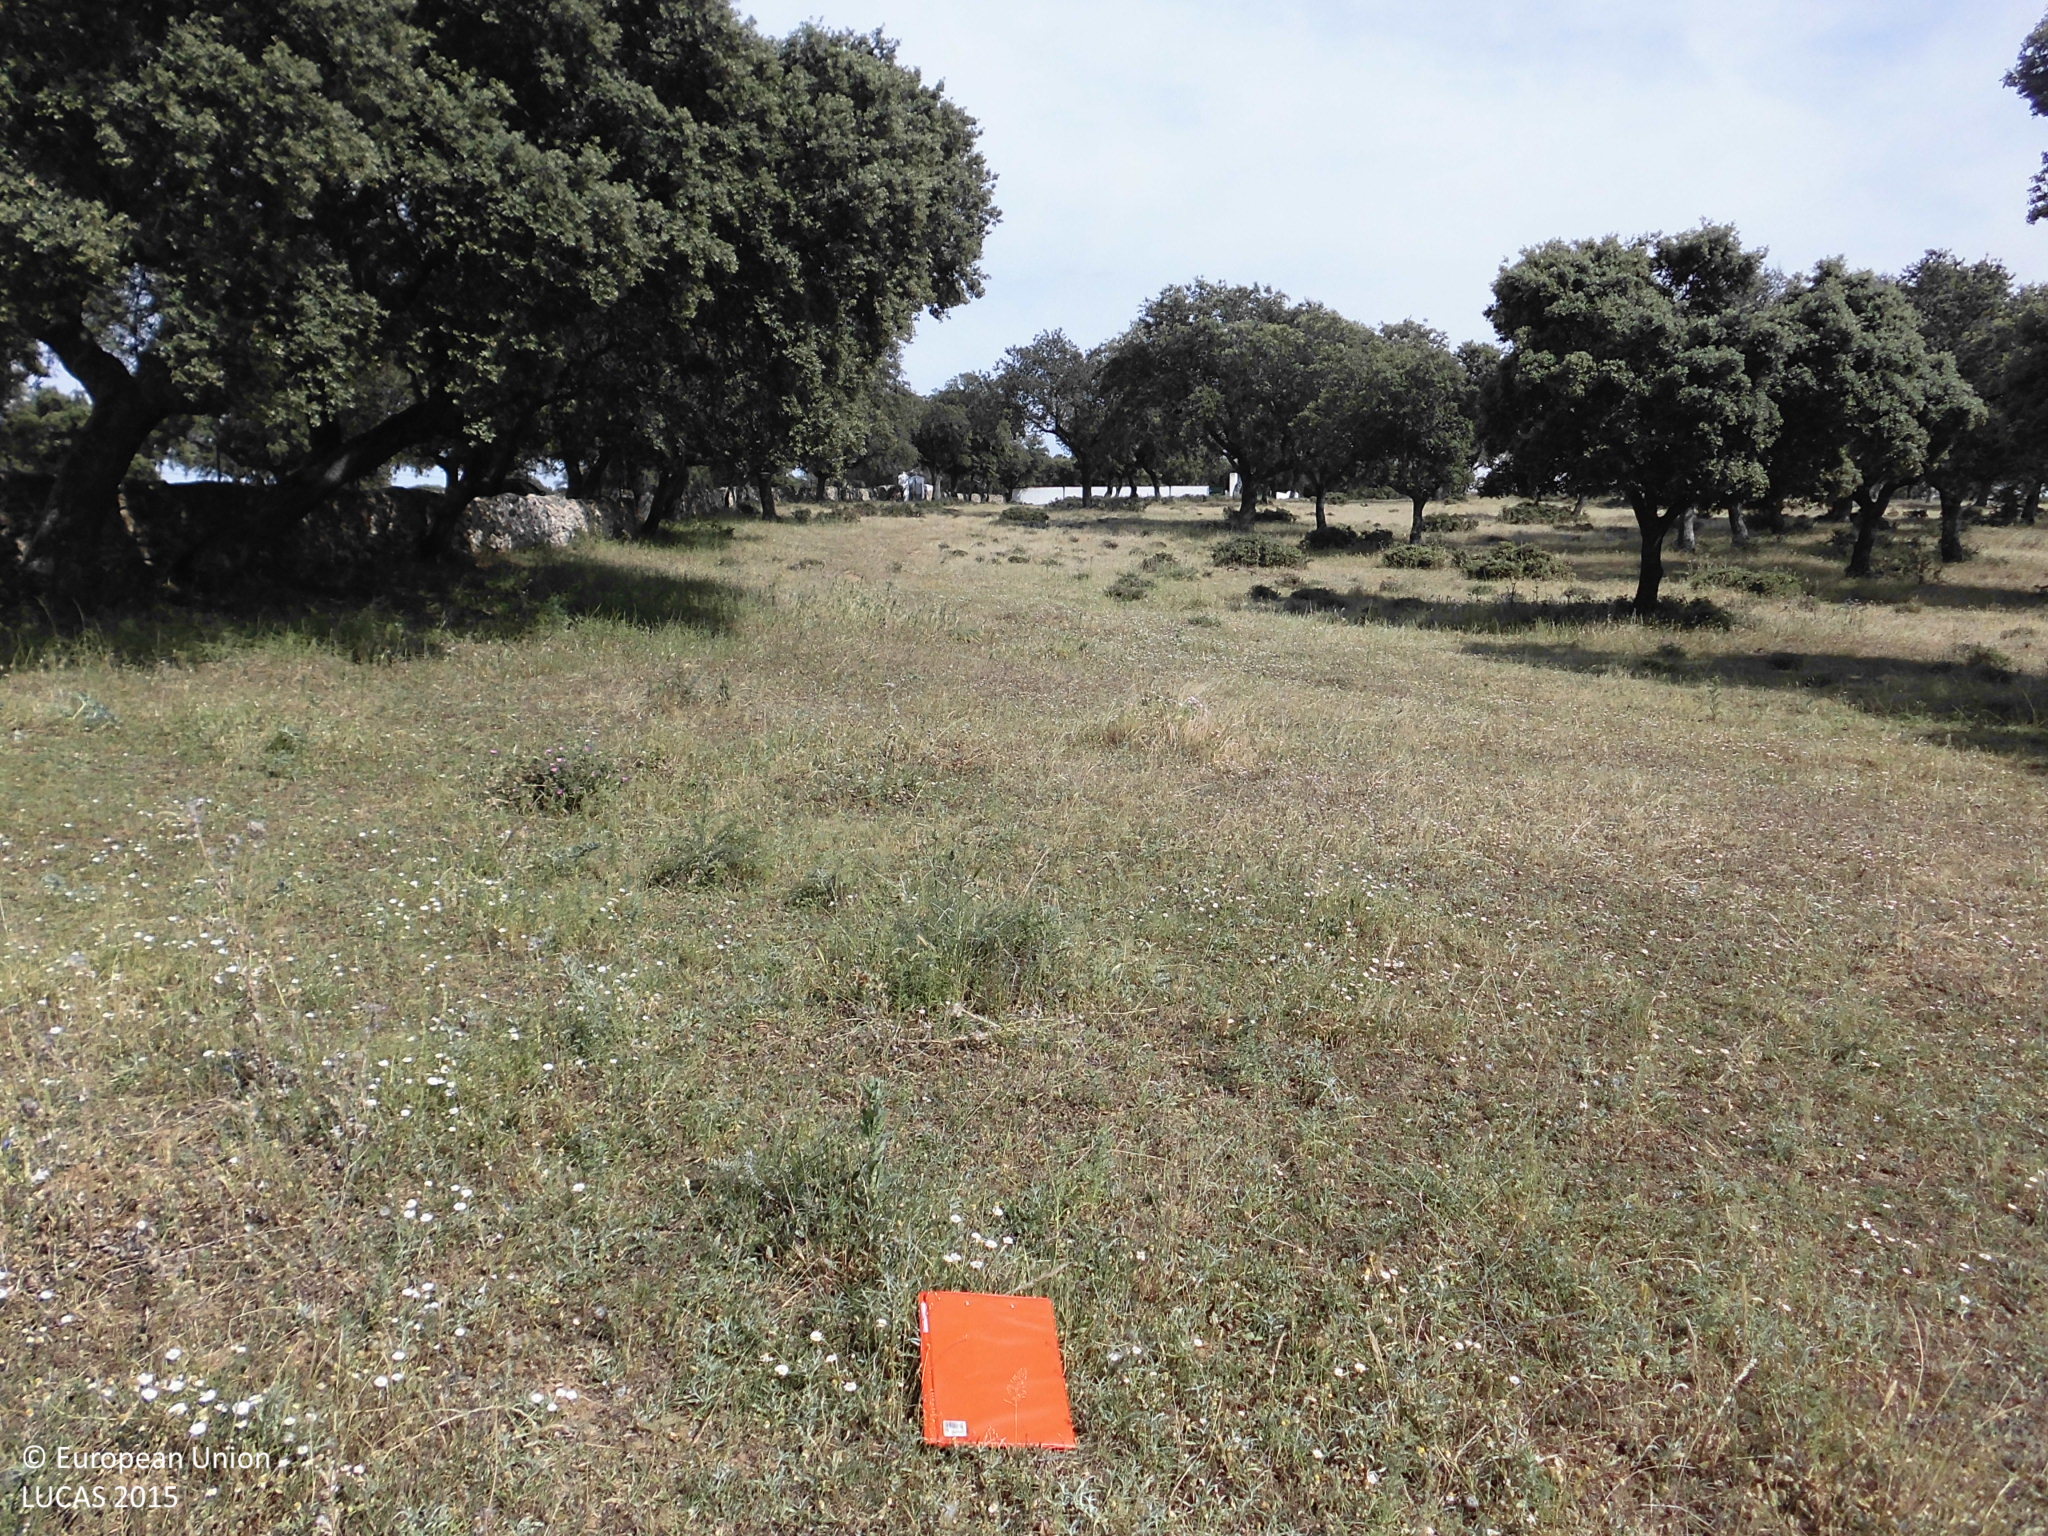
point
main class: Woodland
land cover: Broadleaved woodland
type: broadleaved evergreen forest
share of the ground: 10 - 25 %
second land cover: Grassland without tree/shrub cover
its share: > 75 %
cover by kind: herbaceous plants 75 %, broadleaved forest trees 25 %
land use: Forestry
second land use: Agriculture (excluding fallow land and kitchen gardens)
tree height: > 5 m
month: May
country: ES
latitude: 39.6131
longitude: -6.7224
